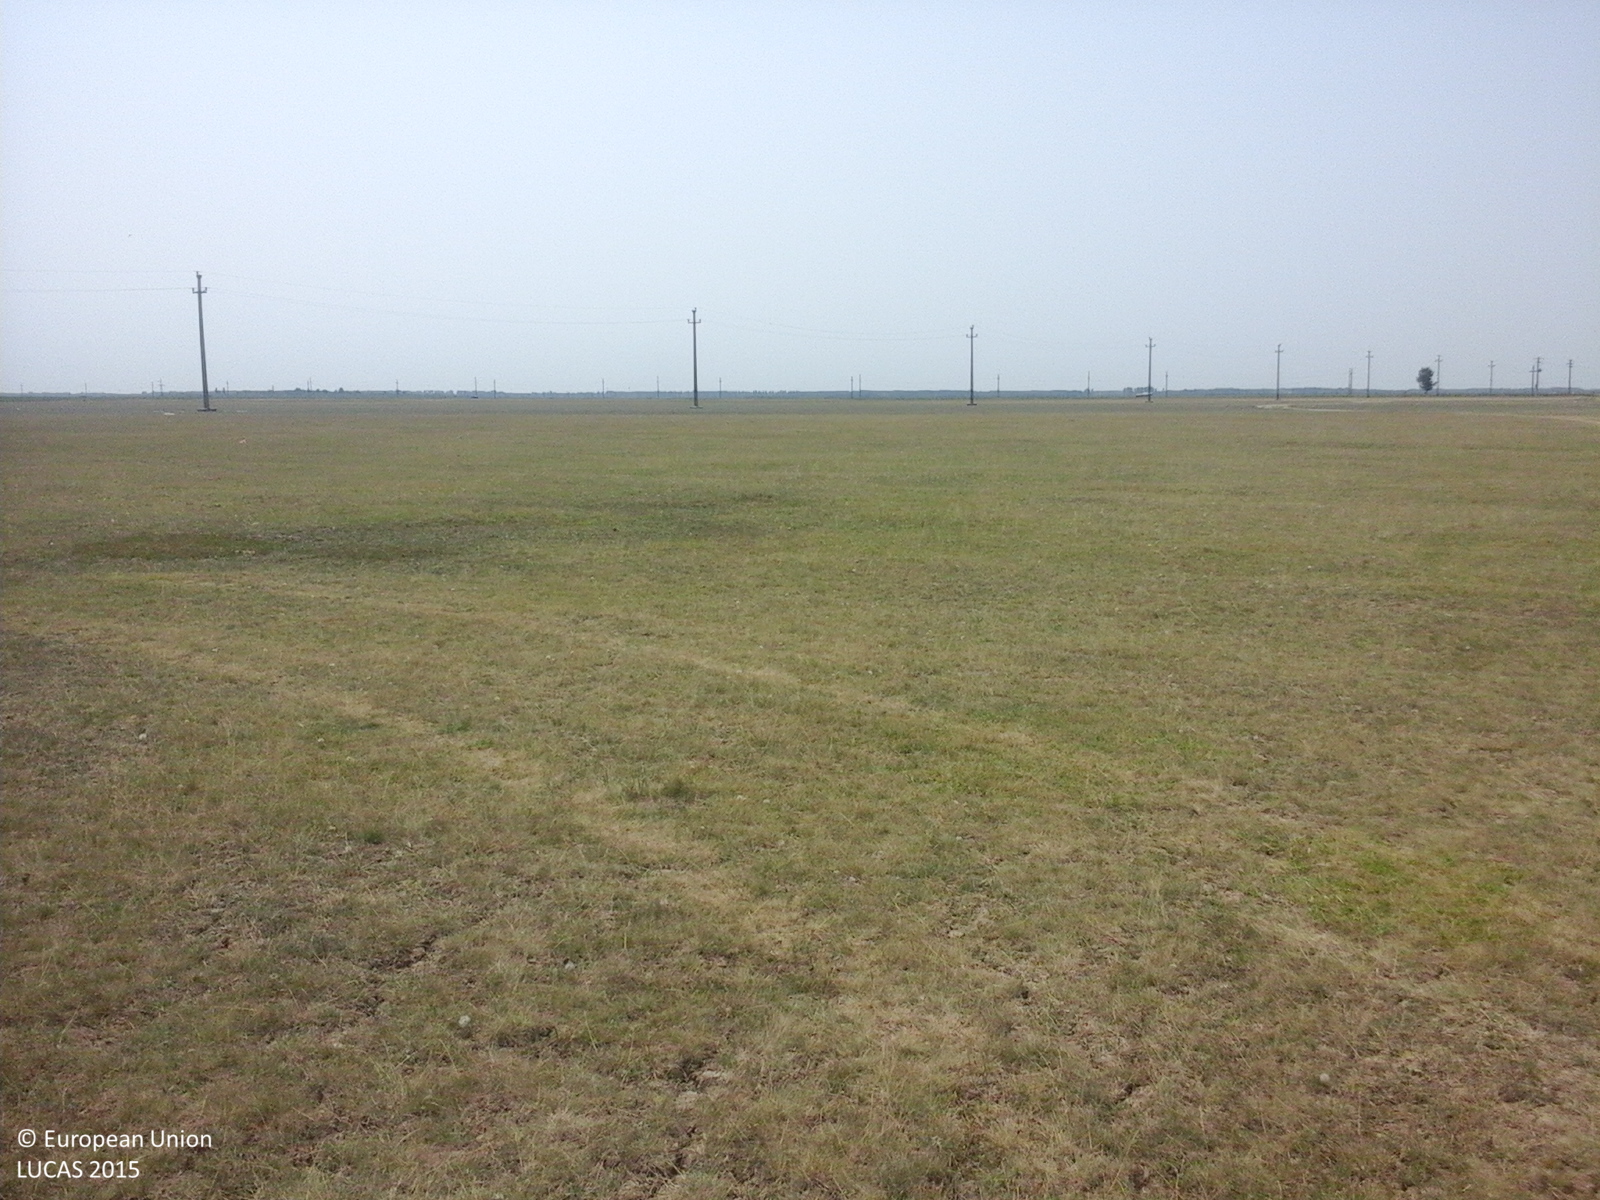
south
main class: Grassland
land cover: Grassland without tree/shrub cover
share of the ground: > 75 %
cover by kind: herbaceous plants 100 %
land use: Agriculture (excluding fallow land and kitchen gardens)
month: July
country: RO
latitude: 44.7558
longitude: 26.5544
